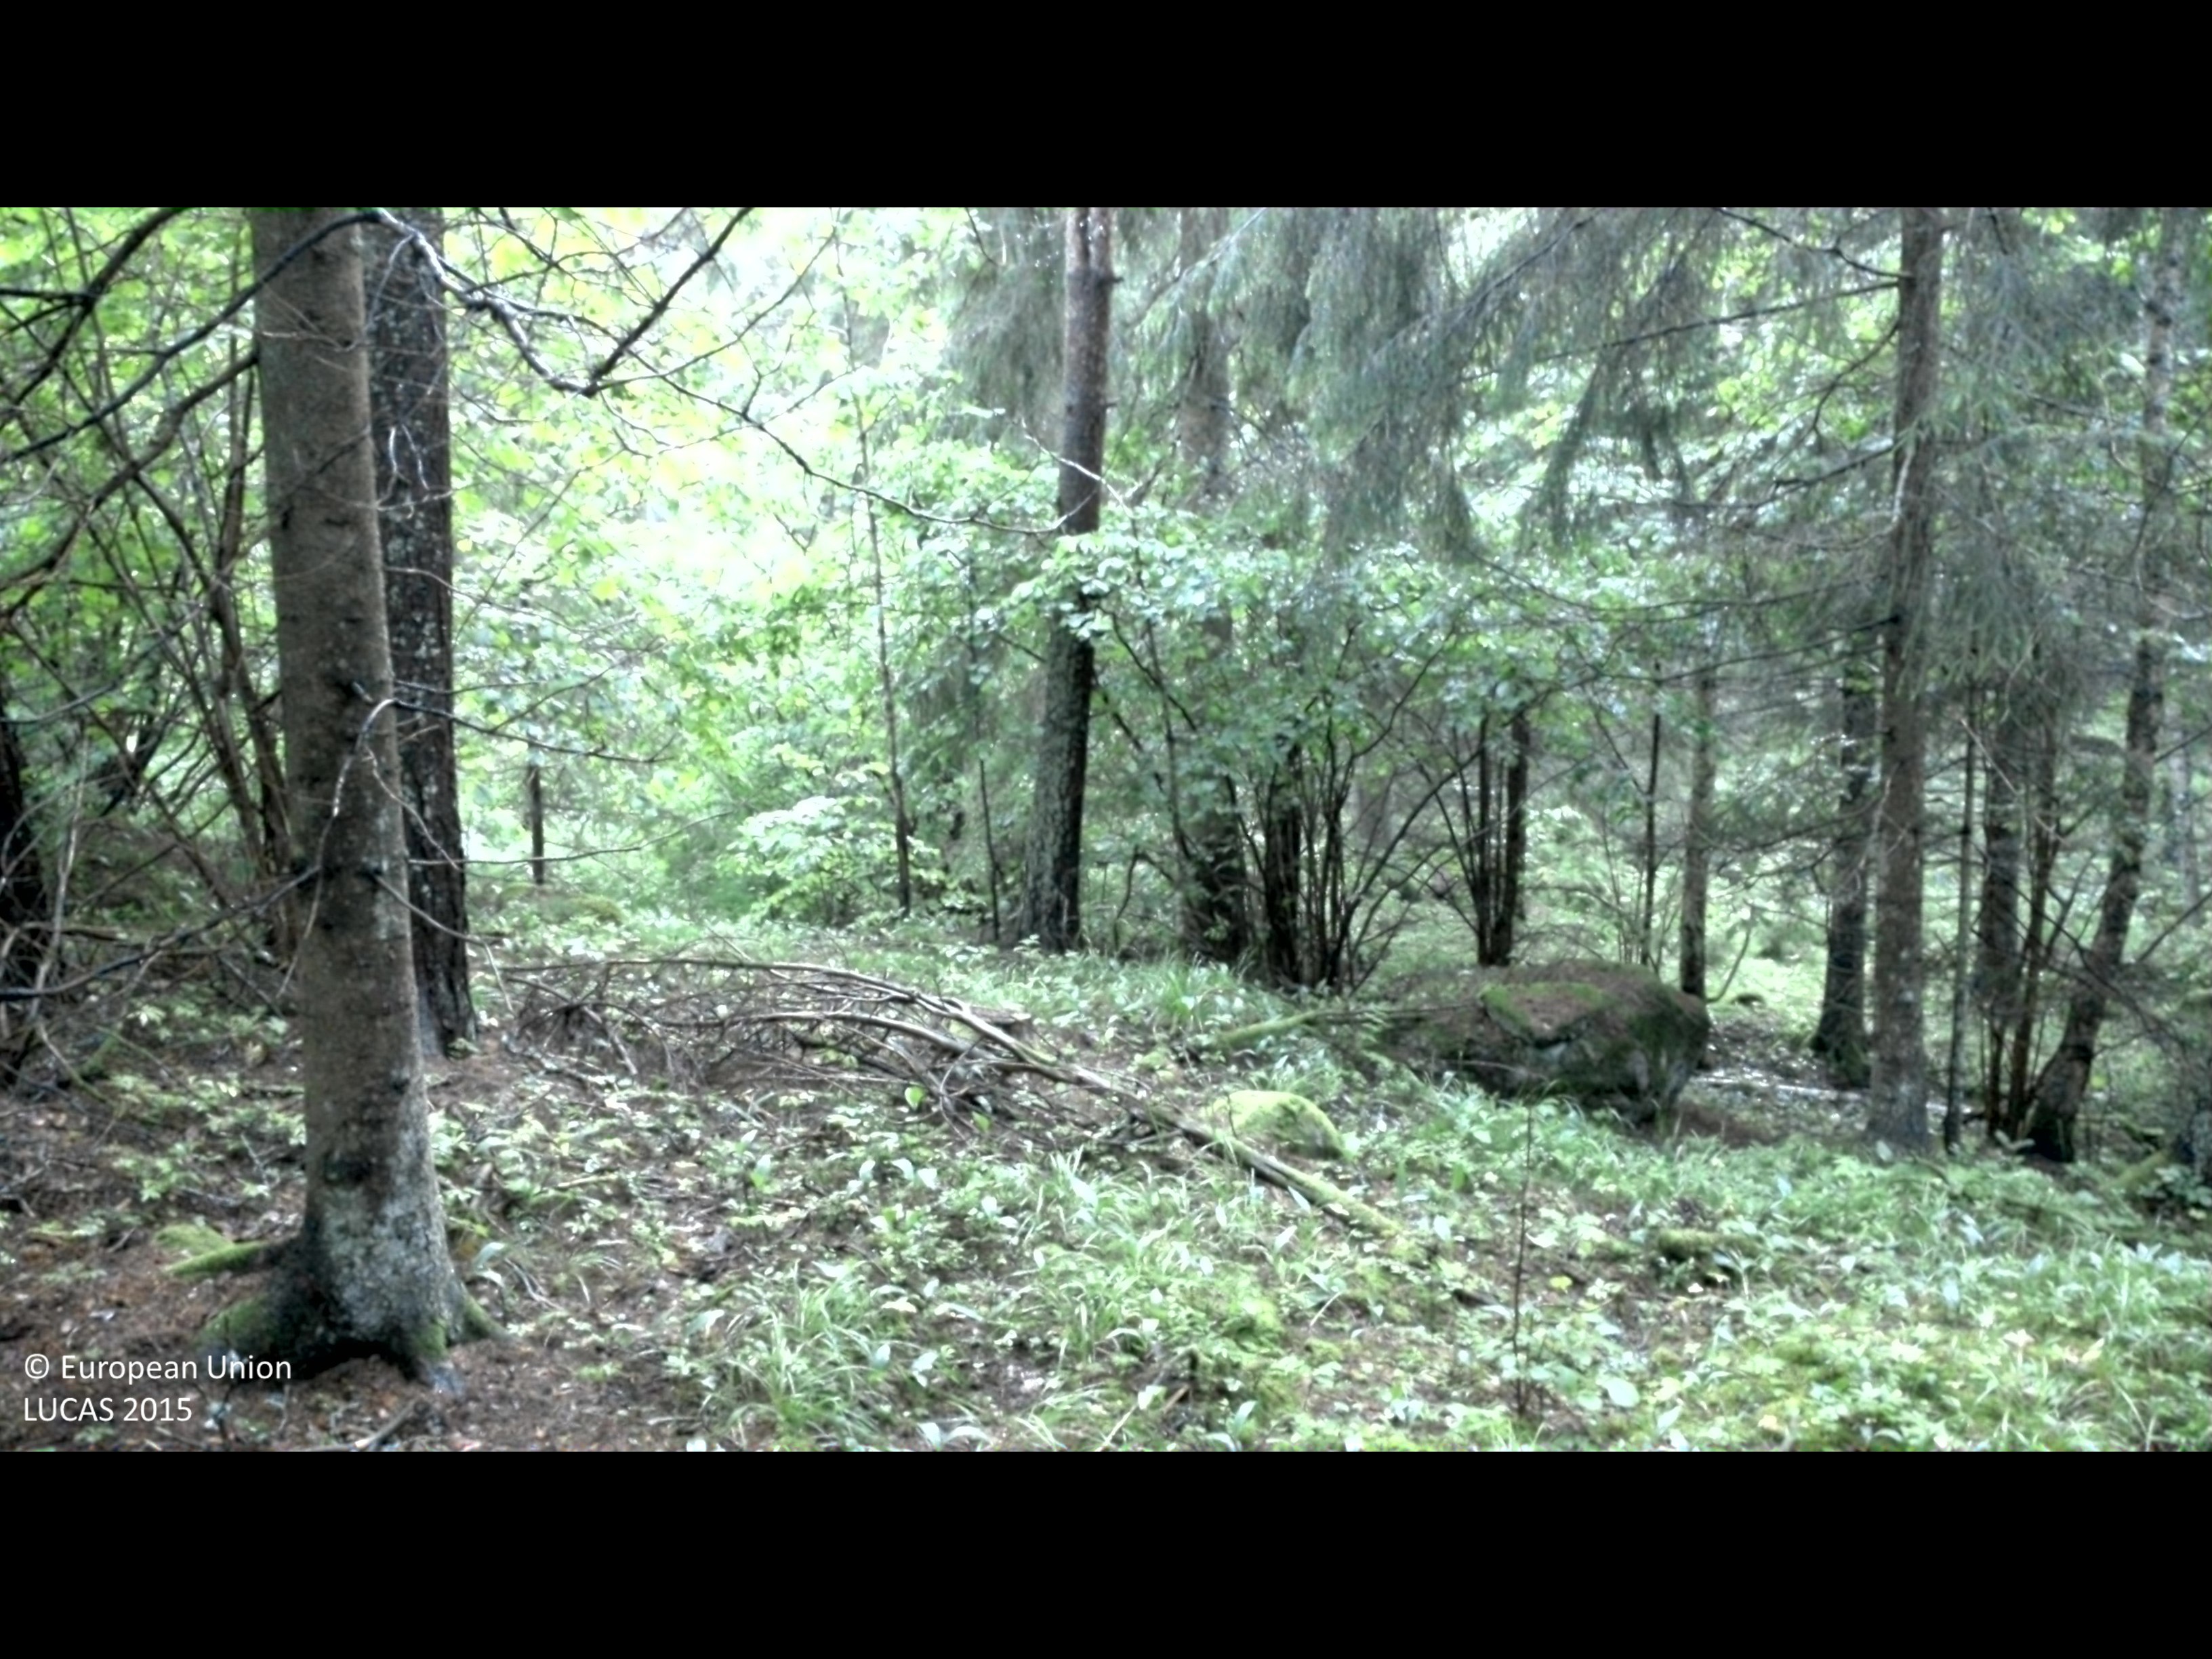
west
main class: Woodland
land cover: Spruce dominated coniferous woodland
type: boreal forest
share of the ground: > 75 %
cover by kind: coniferous forest trees 70 %, broadleaved forest trees 20 %, shrubs 5 %, herbaceous plants 5 %
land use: Forestry
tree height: > 5 m
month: June
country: SE
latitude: 58.0787
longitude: 16.1518
